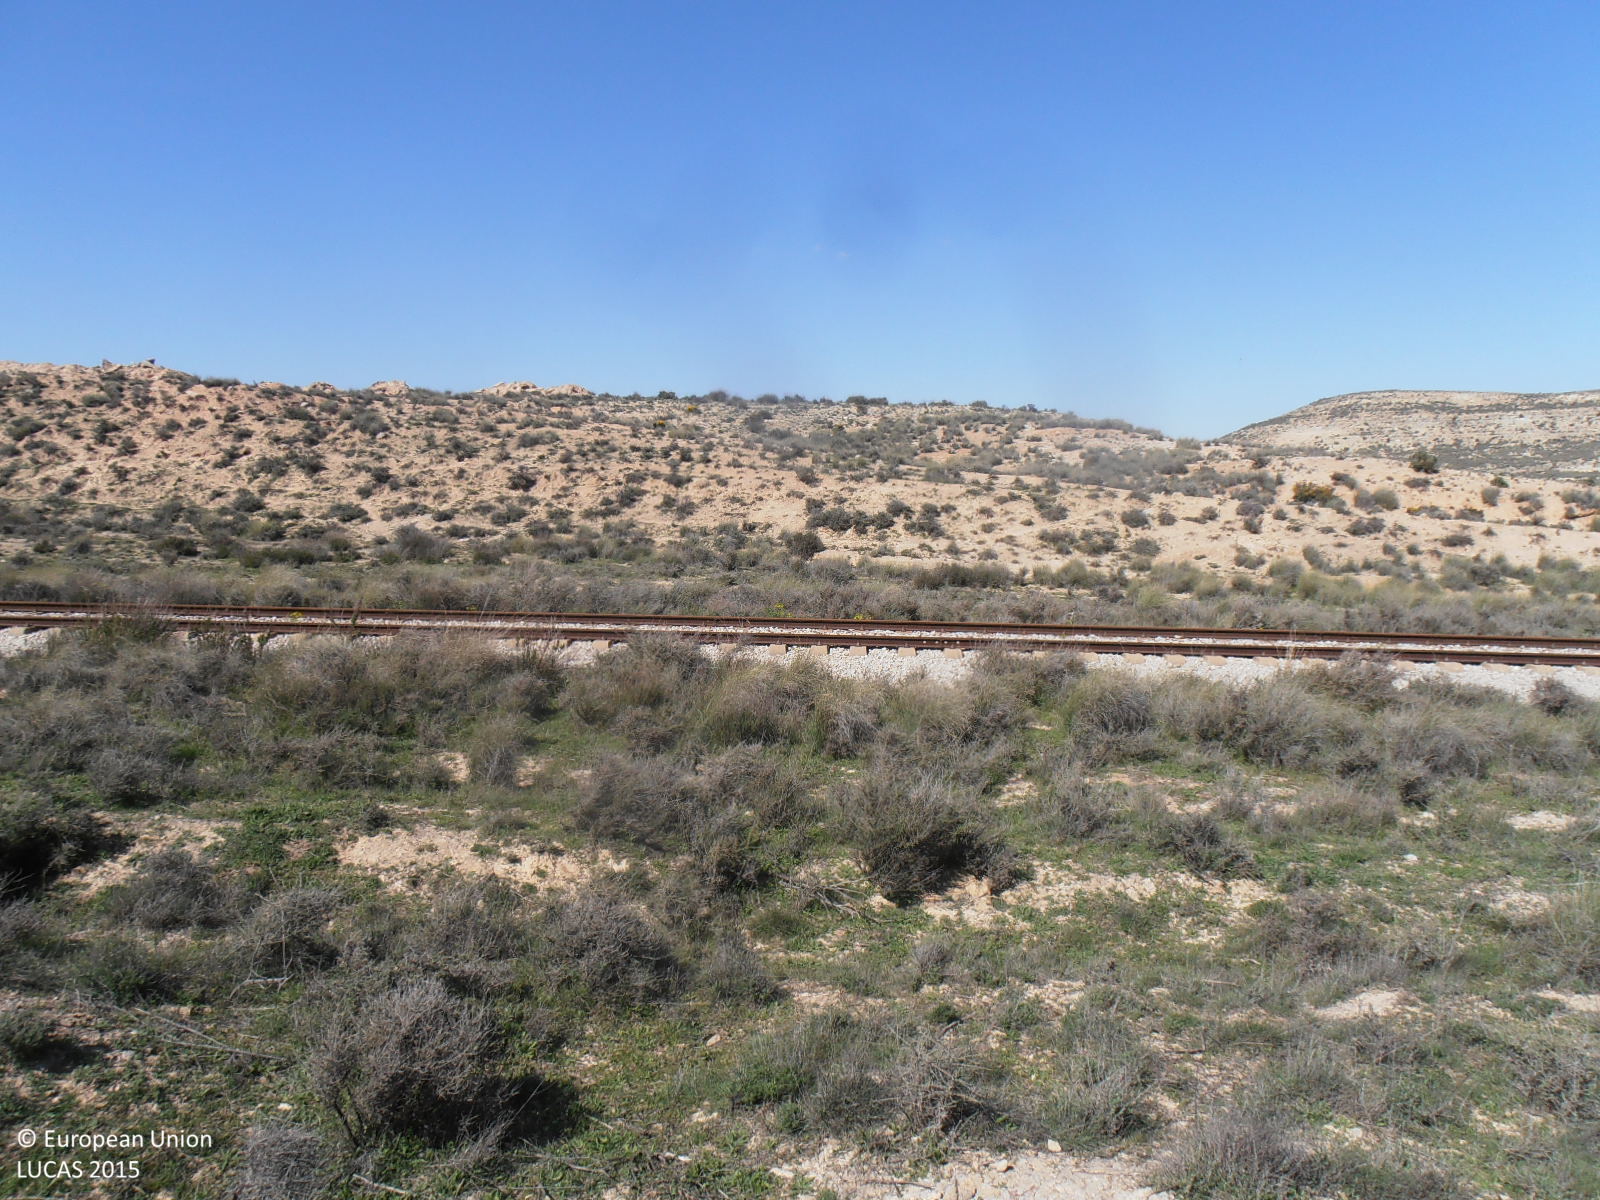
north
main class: Shrubland
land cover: Shrubland without tree cover
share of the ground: 25 - 50 %
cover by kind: unconsolidated bare surface 55 %, shrubs 45 %
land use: Semi-natural and natural areas not in use
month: April
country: ES
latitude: 41.5415
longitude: -1.0140
